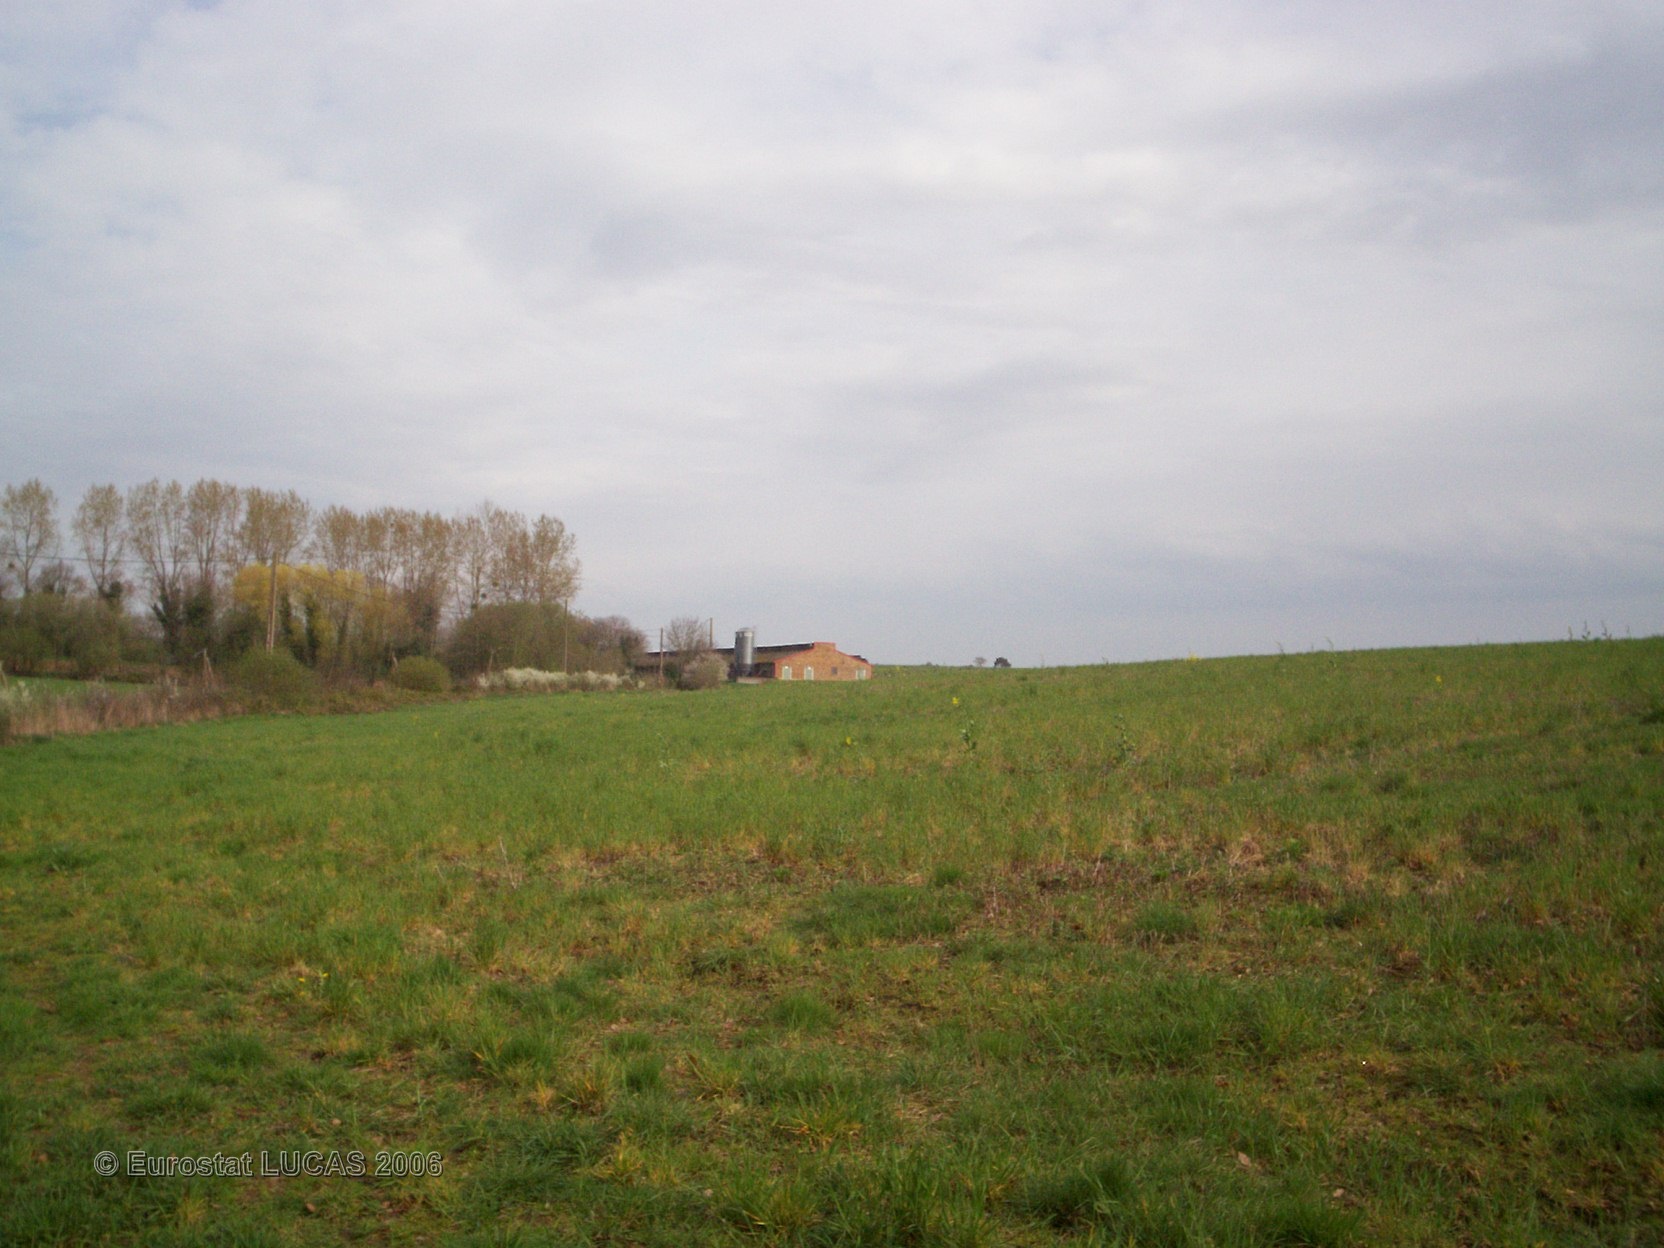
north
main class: Grassland
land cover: Grassland without tree/shrub cover
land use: Agriculture (excluding fallow land and kitchen gardens)
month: April
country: FR
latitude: 48.0475
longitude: -2.8771
